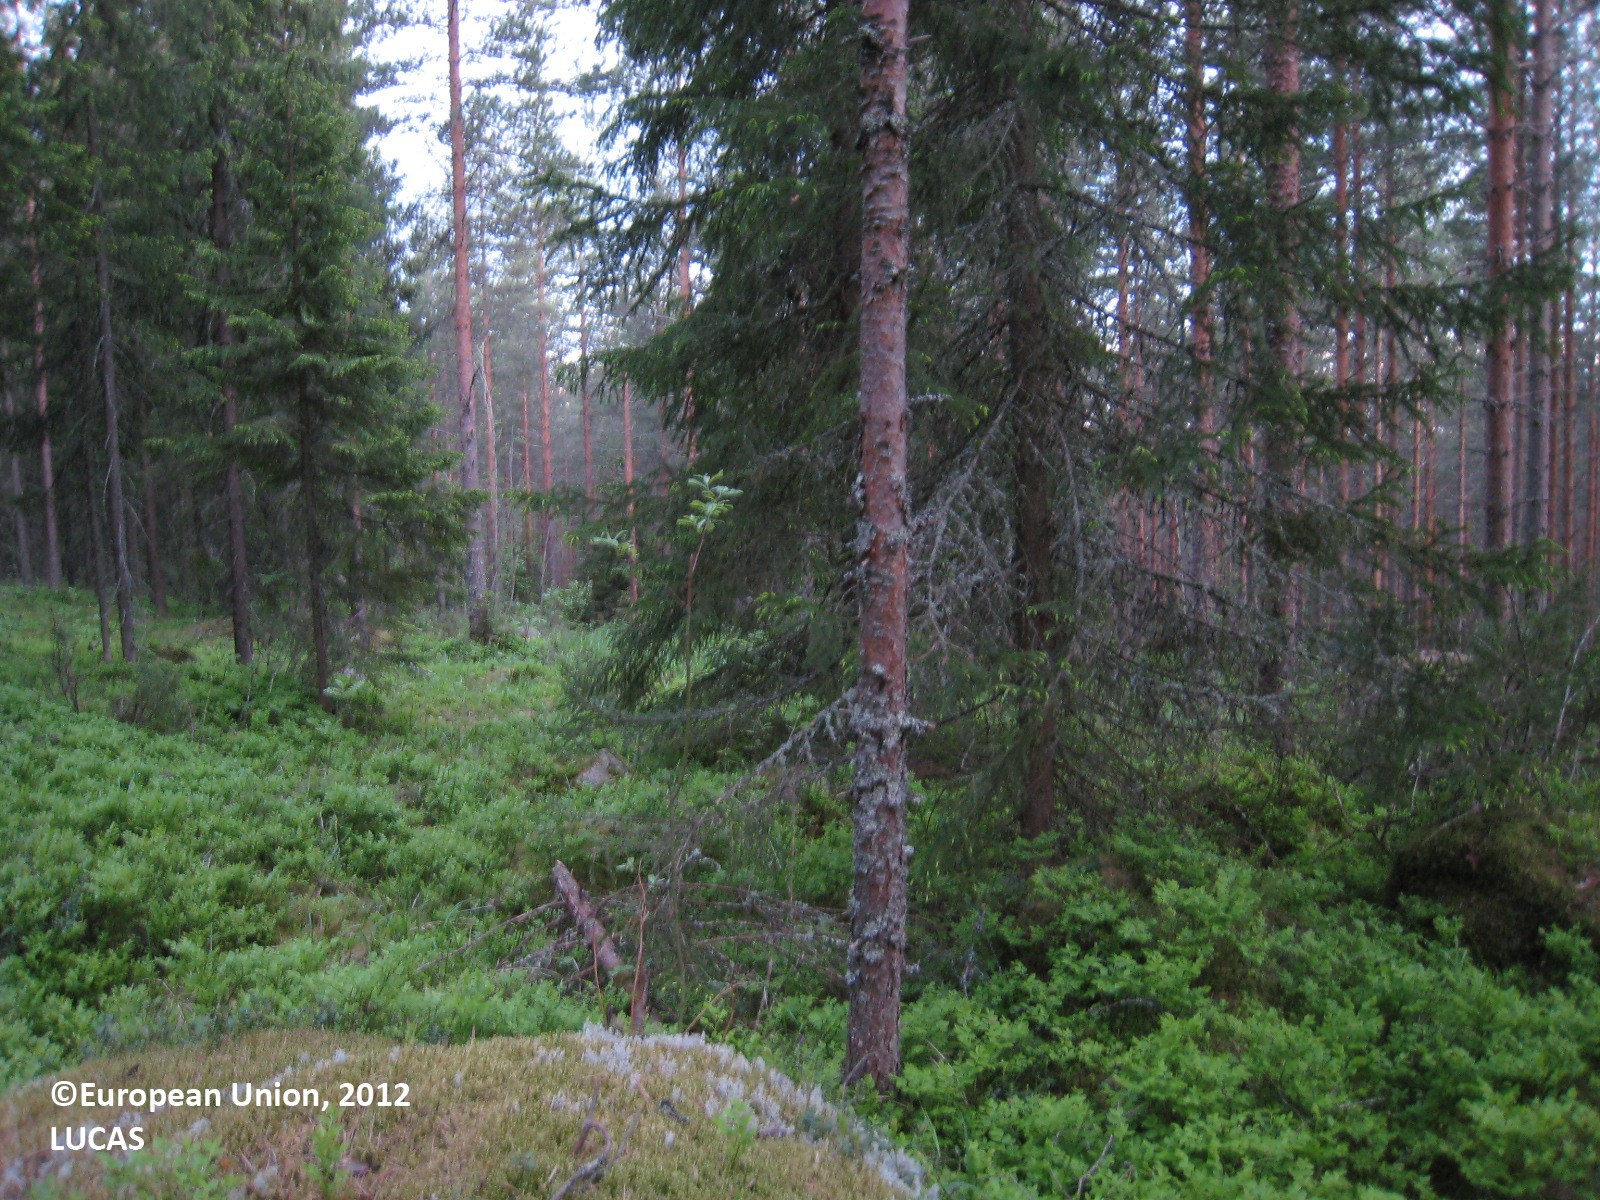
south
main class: Woodland
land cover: Pine dominated coniferous woodland
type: boreal forest
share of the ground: 50 - 75 %
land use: Forestry
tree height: > 5 m
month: June
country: FI
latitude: 62.5594
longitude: 26.0156
